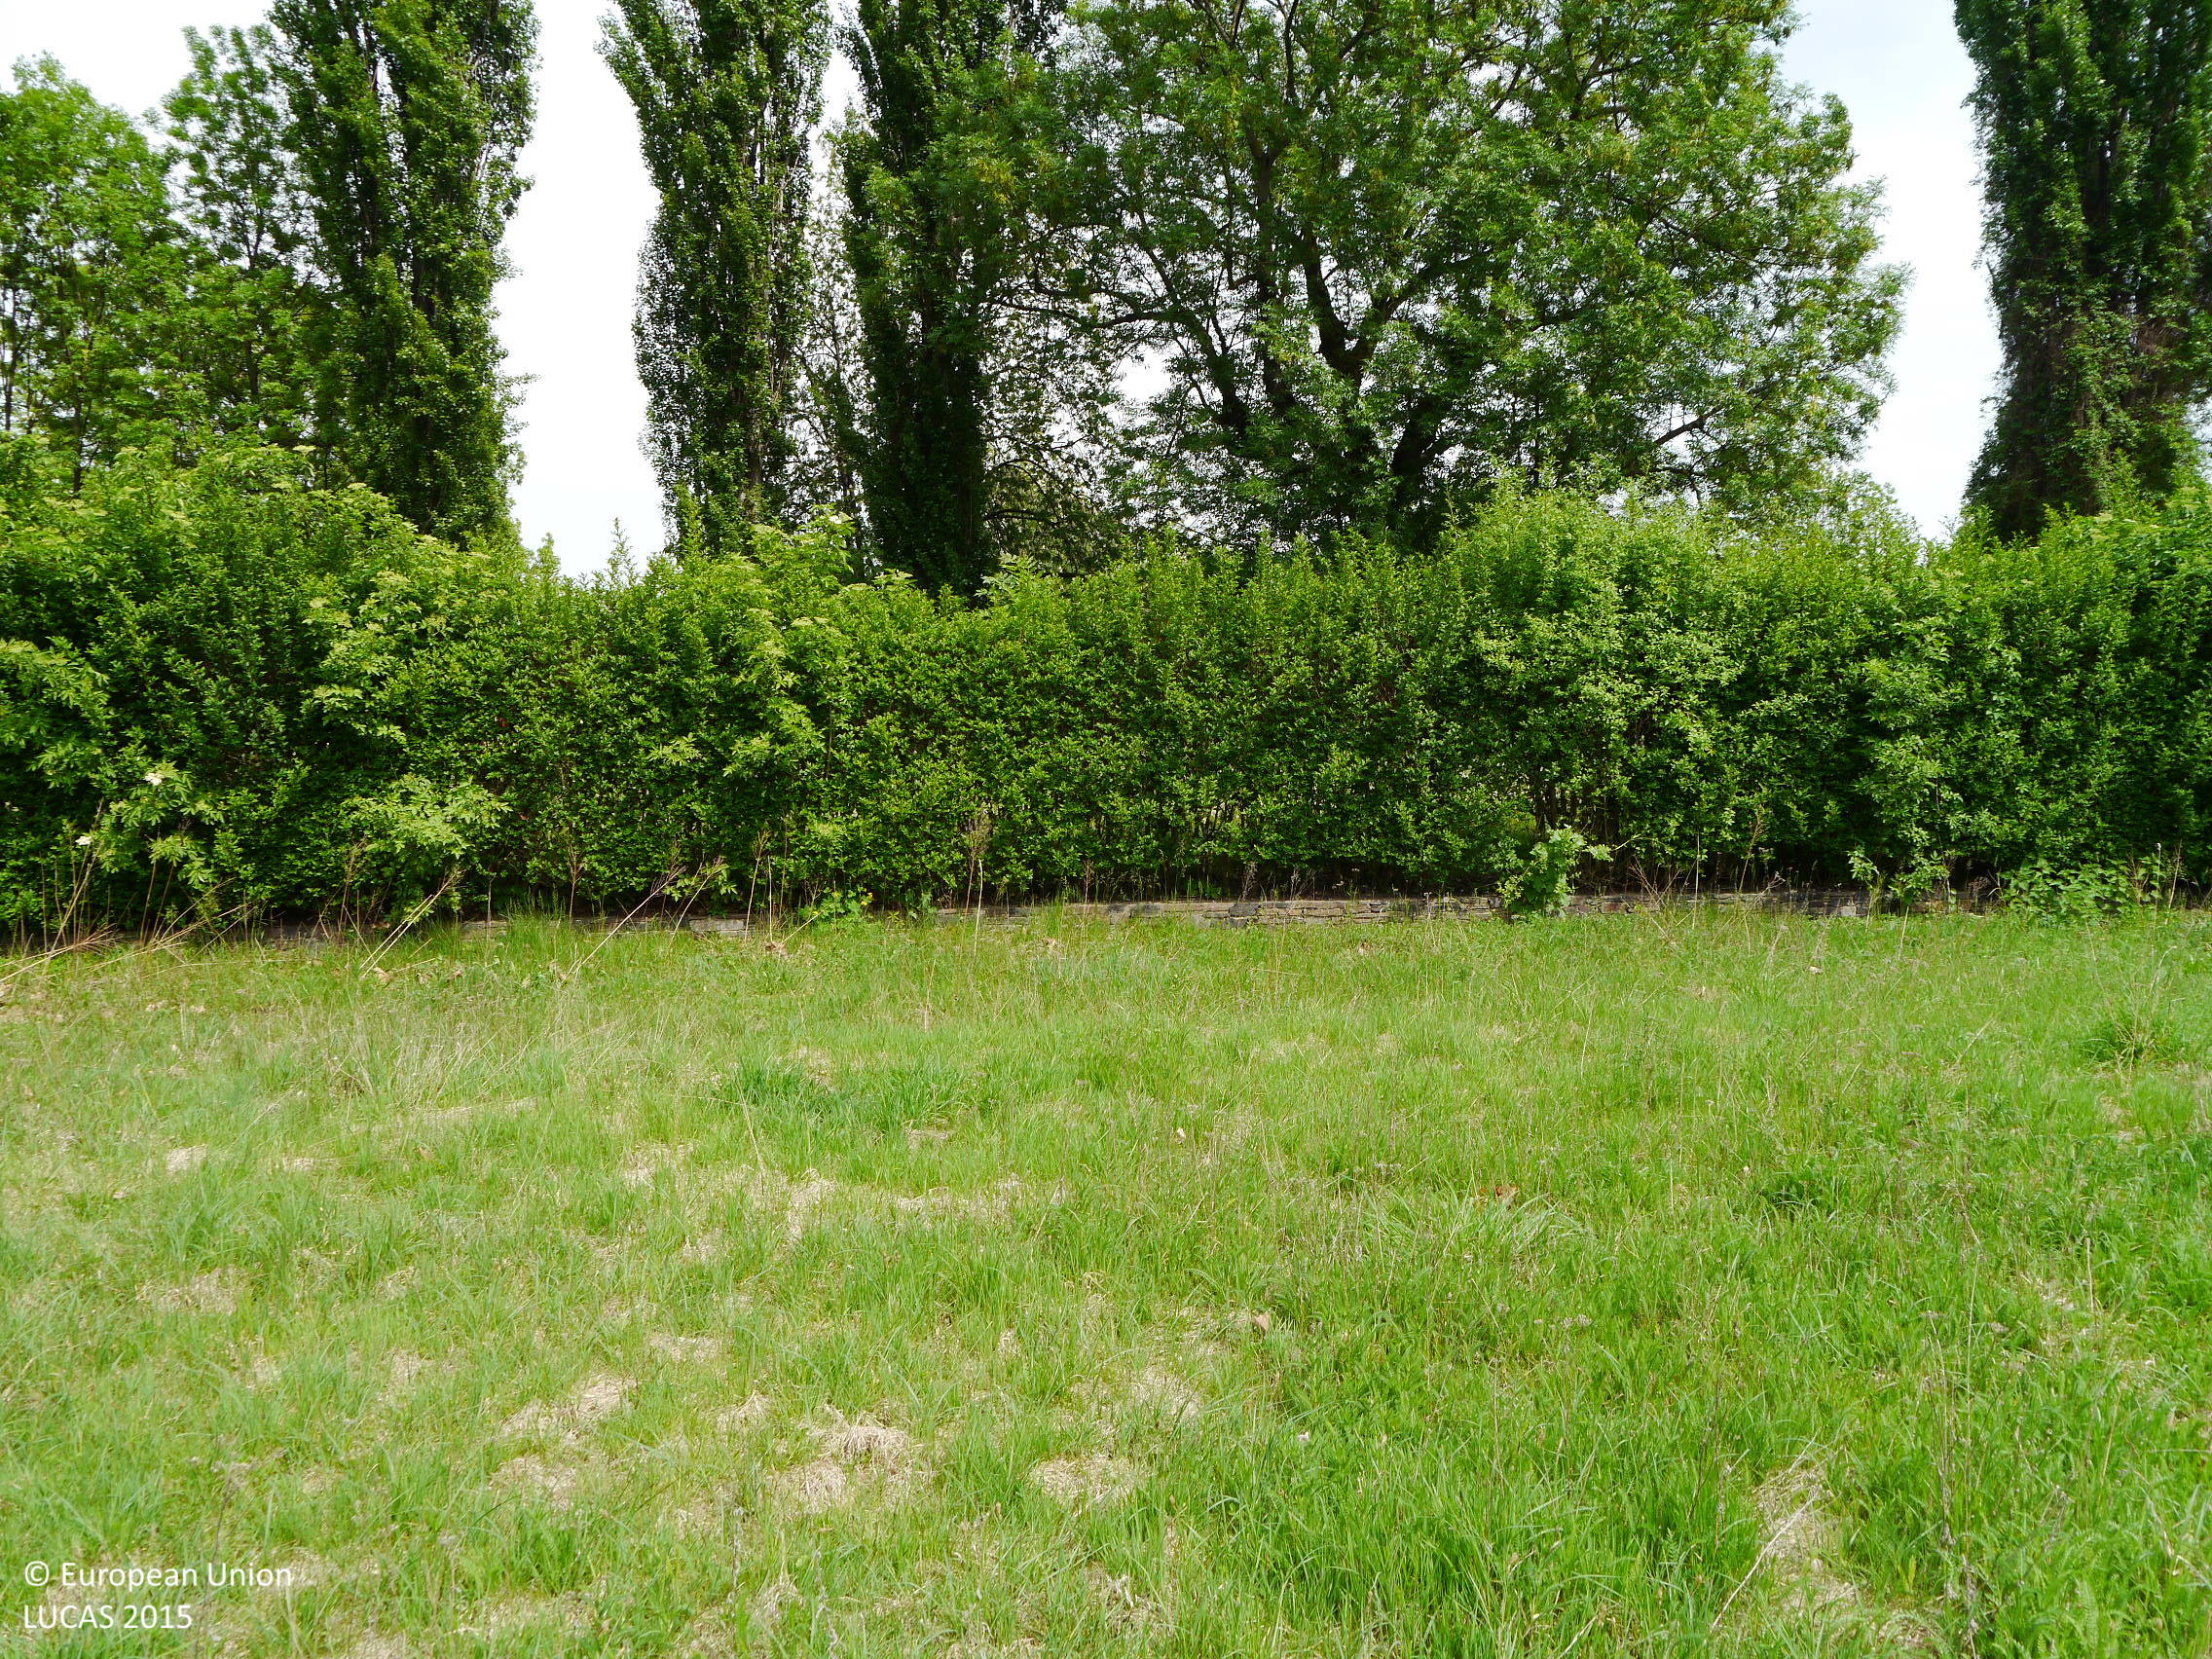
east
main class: Grassland
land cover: Grassland without tree/shrub cover
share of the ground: > 75 %
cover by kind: herbaceous plants 100 %
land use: Sport
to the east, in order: Grassland without tree/shrub cover; Dry stone walls; Managed hedges; Grassland without tree/shrub cover; Tracks; Grassland with sparse tree/shrub cover; Artificial constructions in urban areas; Grass margins; Paved roads, cycling and walking lanes; Lines of trees; Paved roads, cycling and walking lanes; Grass margins; Other fresh vegetables
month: May
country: AT
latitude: 47.0625
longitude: 15.4112
